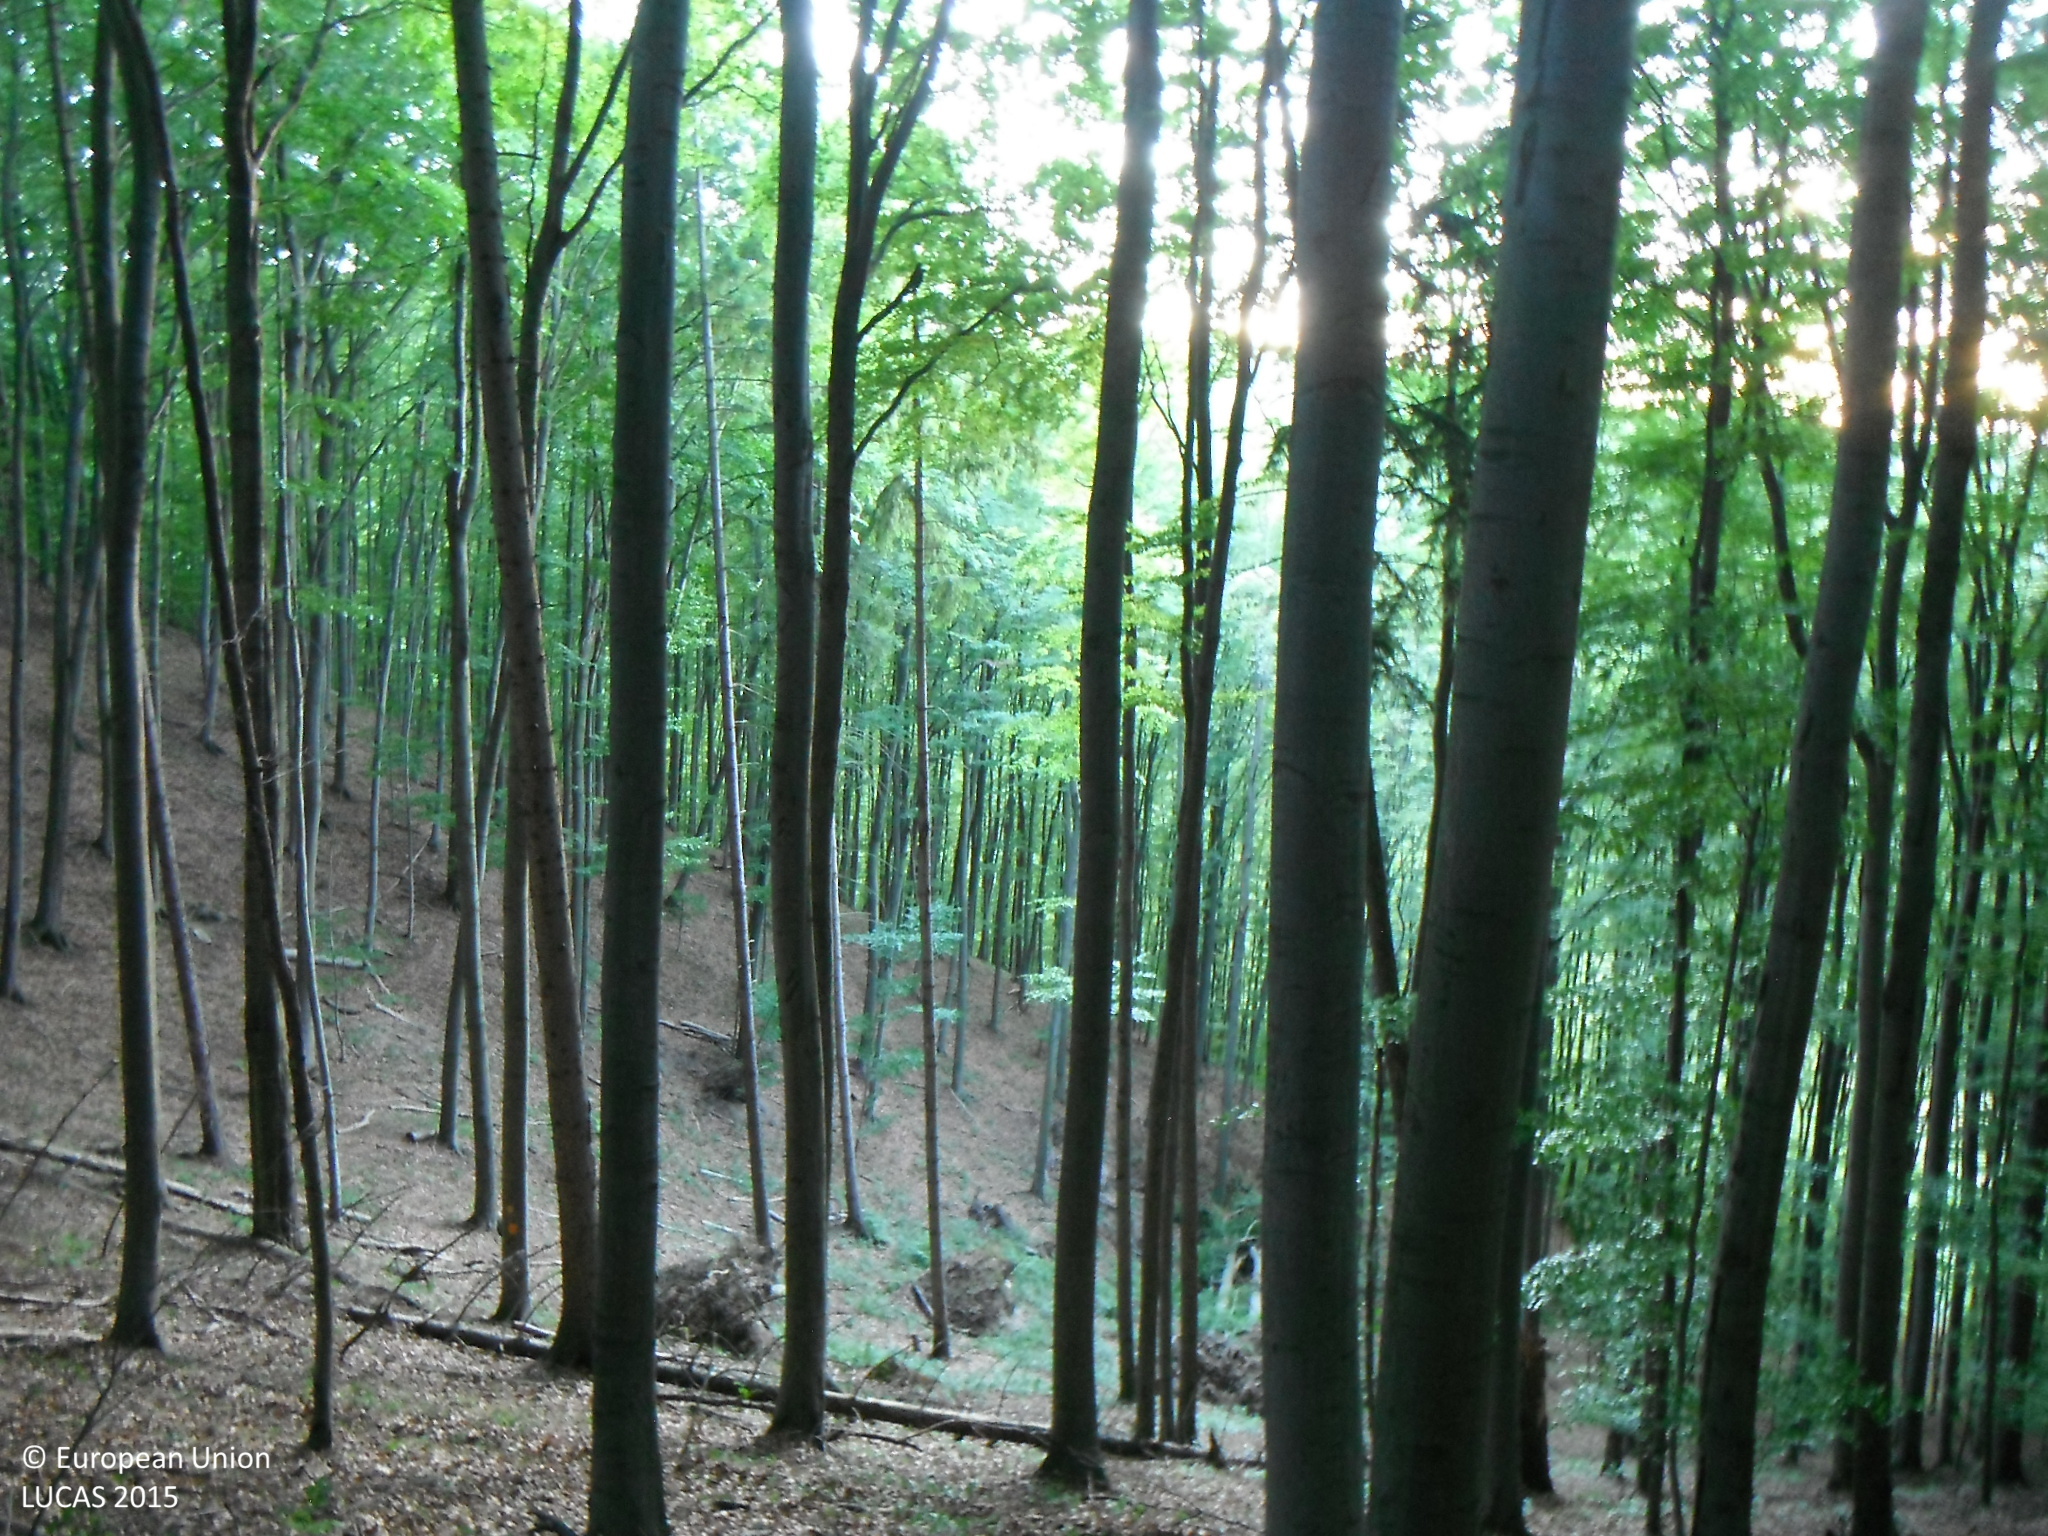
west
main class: Woodland
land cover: Broadleaved woodland
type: beech forest
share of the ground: > 75 %
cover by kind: broadleaved forest trees 100 %
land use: Forestry
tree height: > 5 m
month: July
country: SK
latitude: 48.5470
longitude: 18.9473
